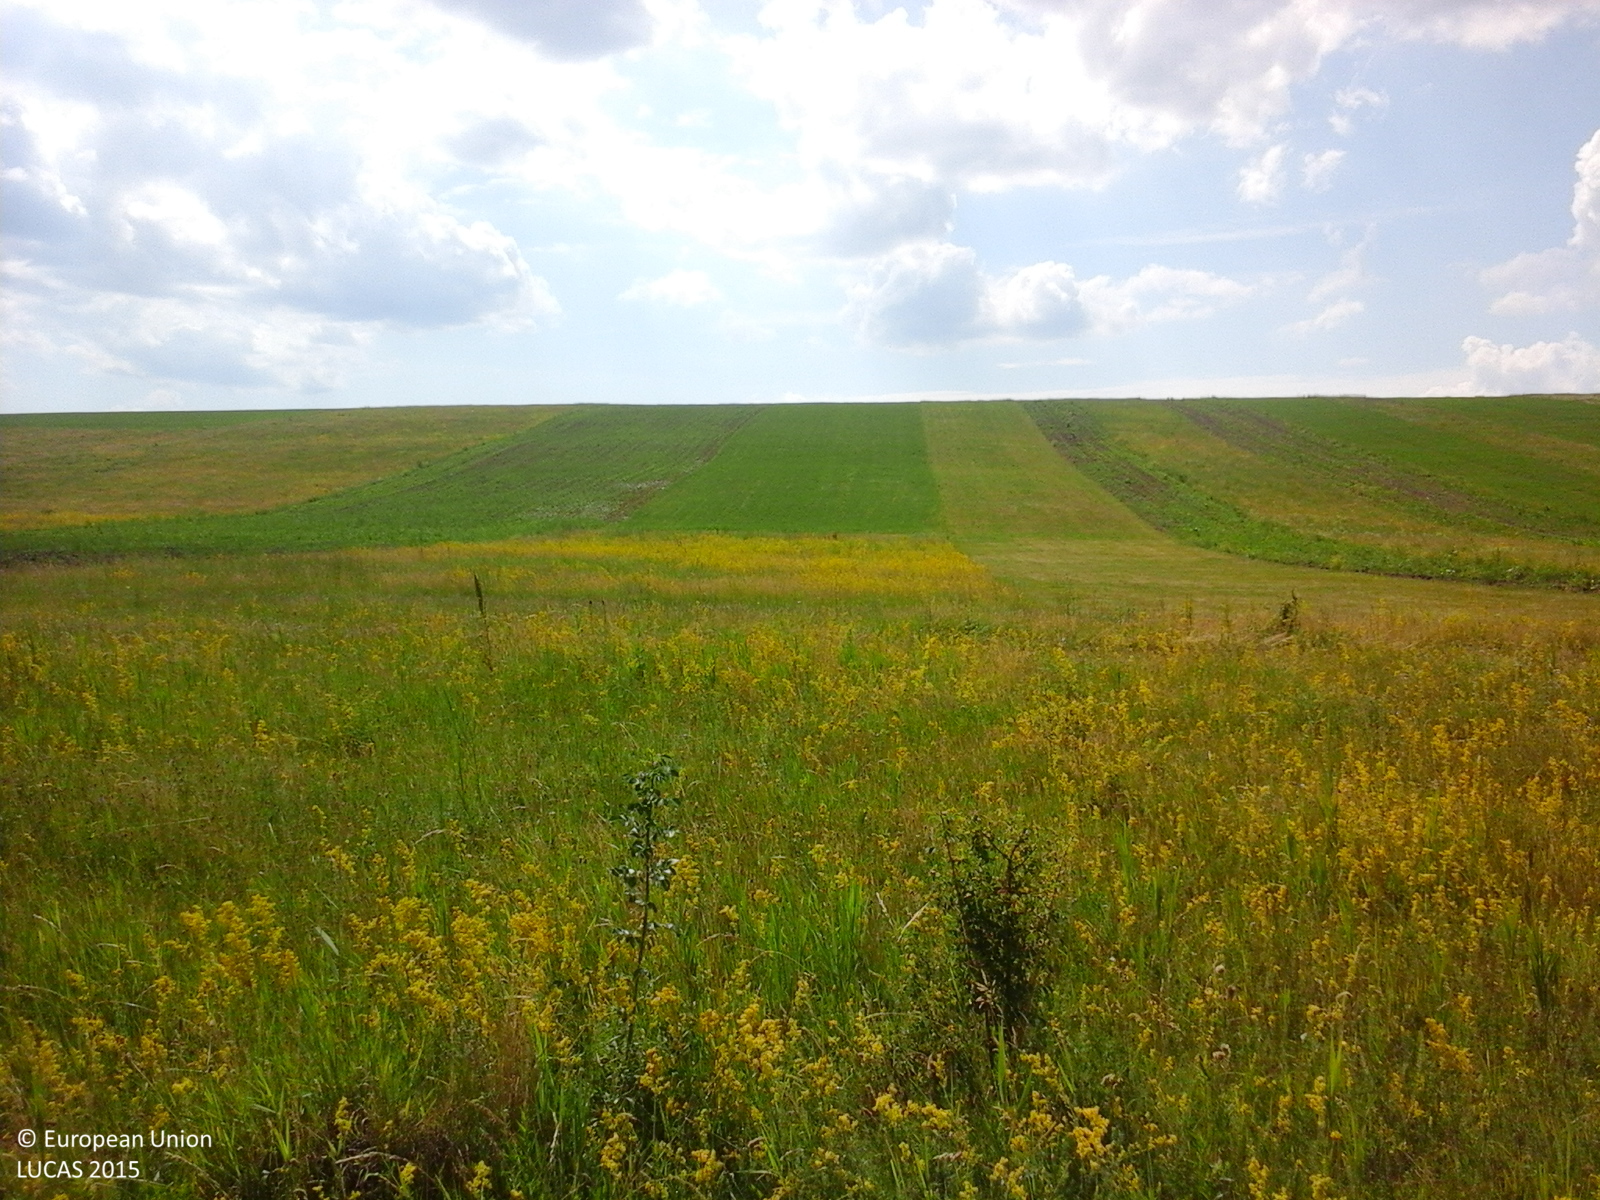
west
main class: Grassland
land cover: Grassland without tree/shrub cover
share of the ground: > 75 %
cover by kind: herbaceous plants 100 %
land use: Agriculture (excluding fallow land and kitchen gardens)
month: June
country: RO
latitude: 47.9068
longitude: 26.3696
